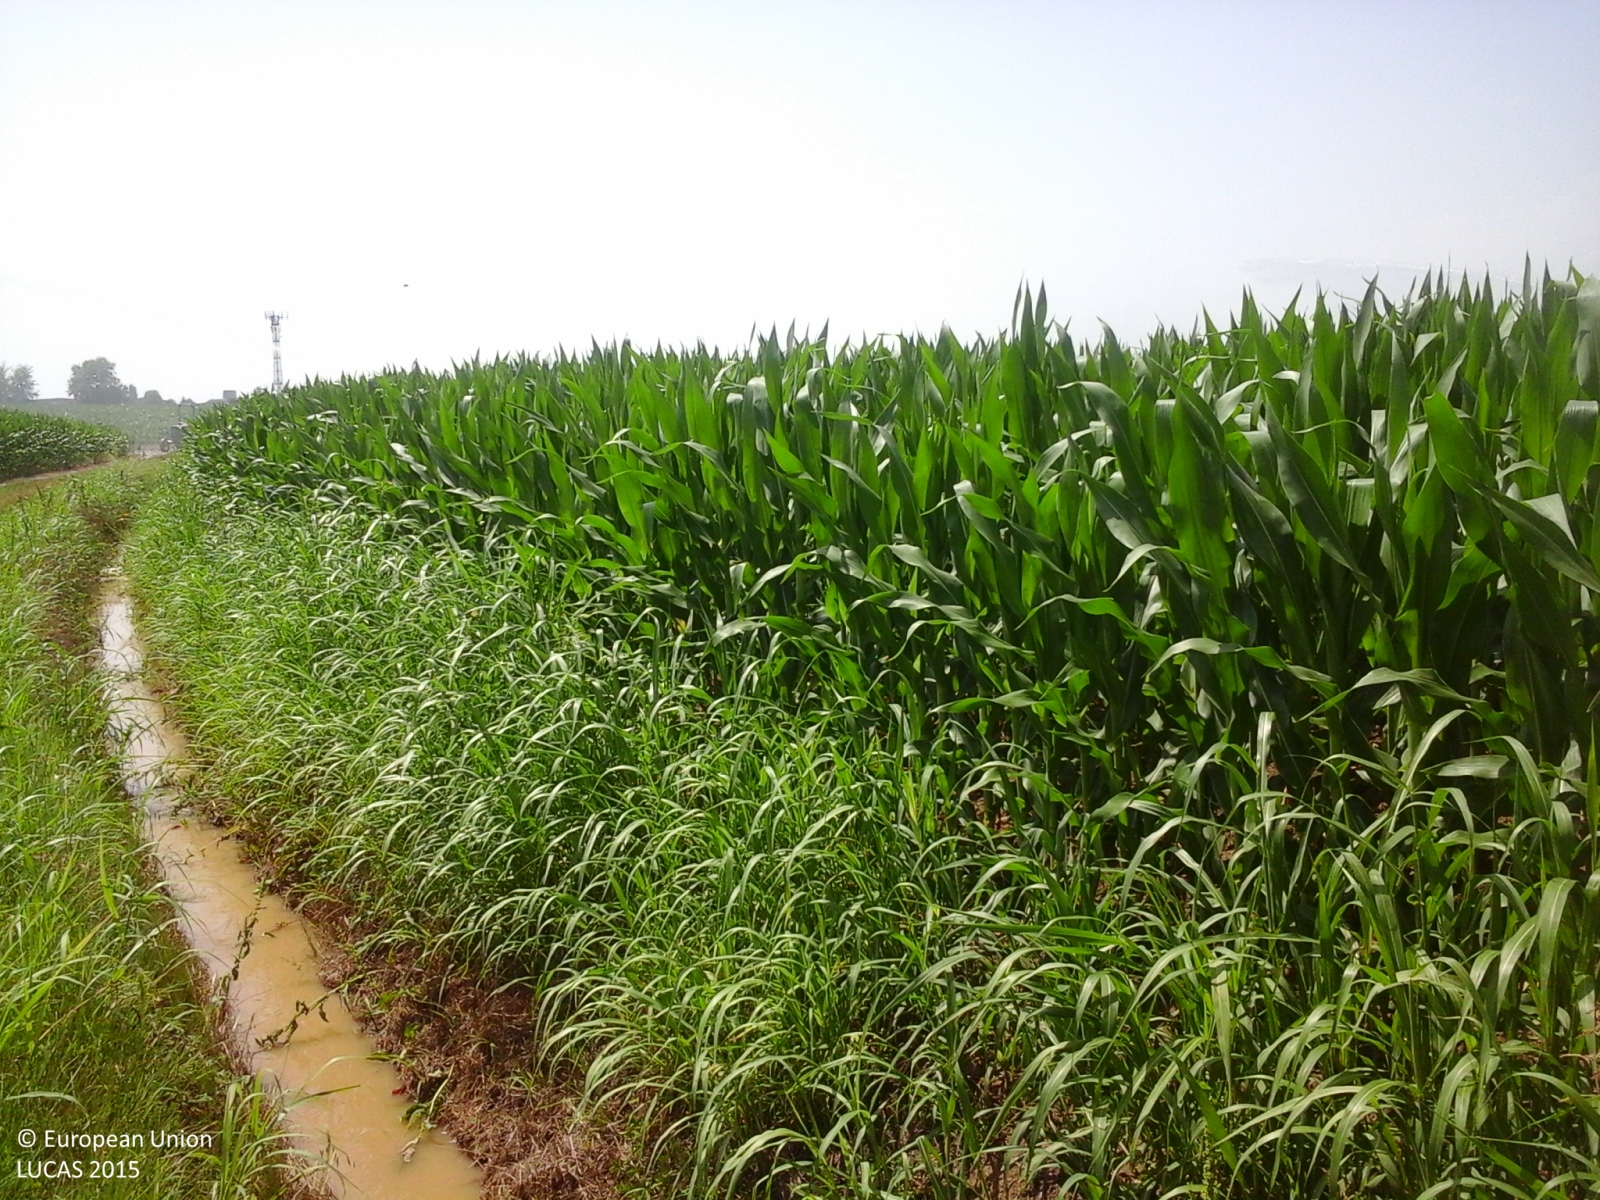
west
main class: Cropland
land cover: Maize
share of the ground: > 75 %
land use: Agriculture (excluding fallow land and kitchen gardens)
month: June
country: IT
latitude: 45.2463
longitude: 11.1064
